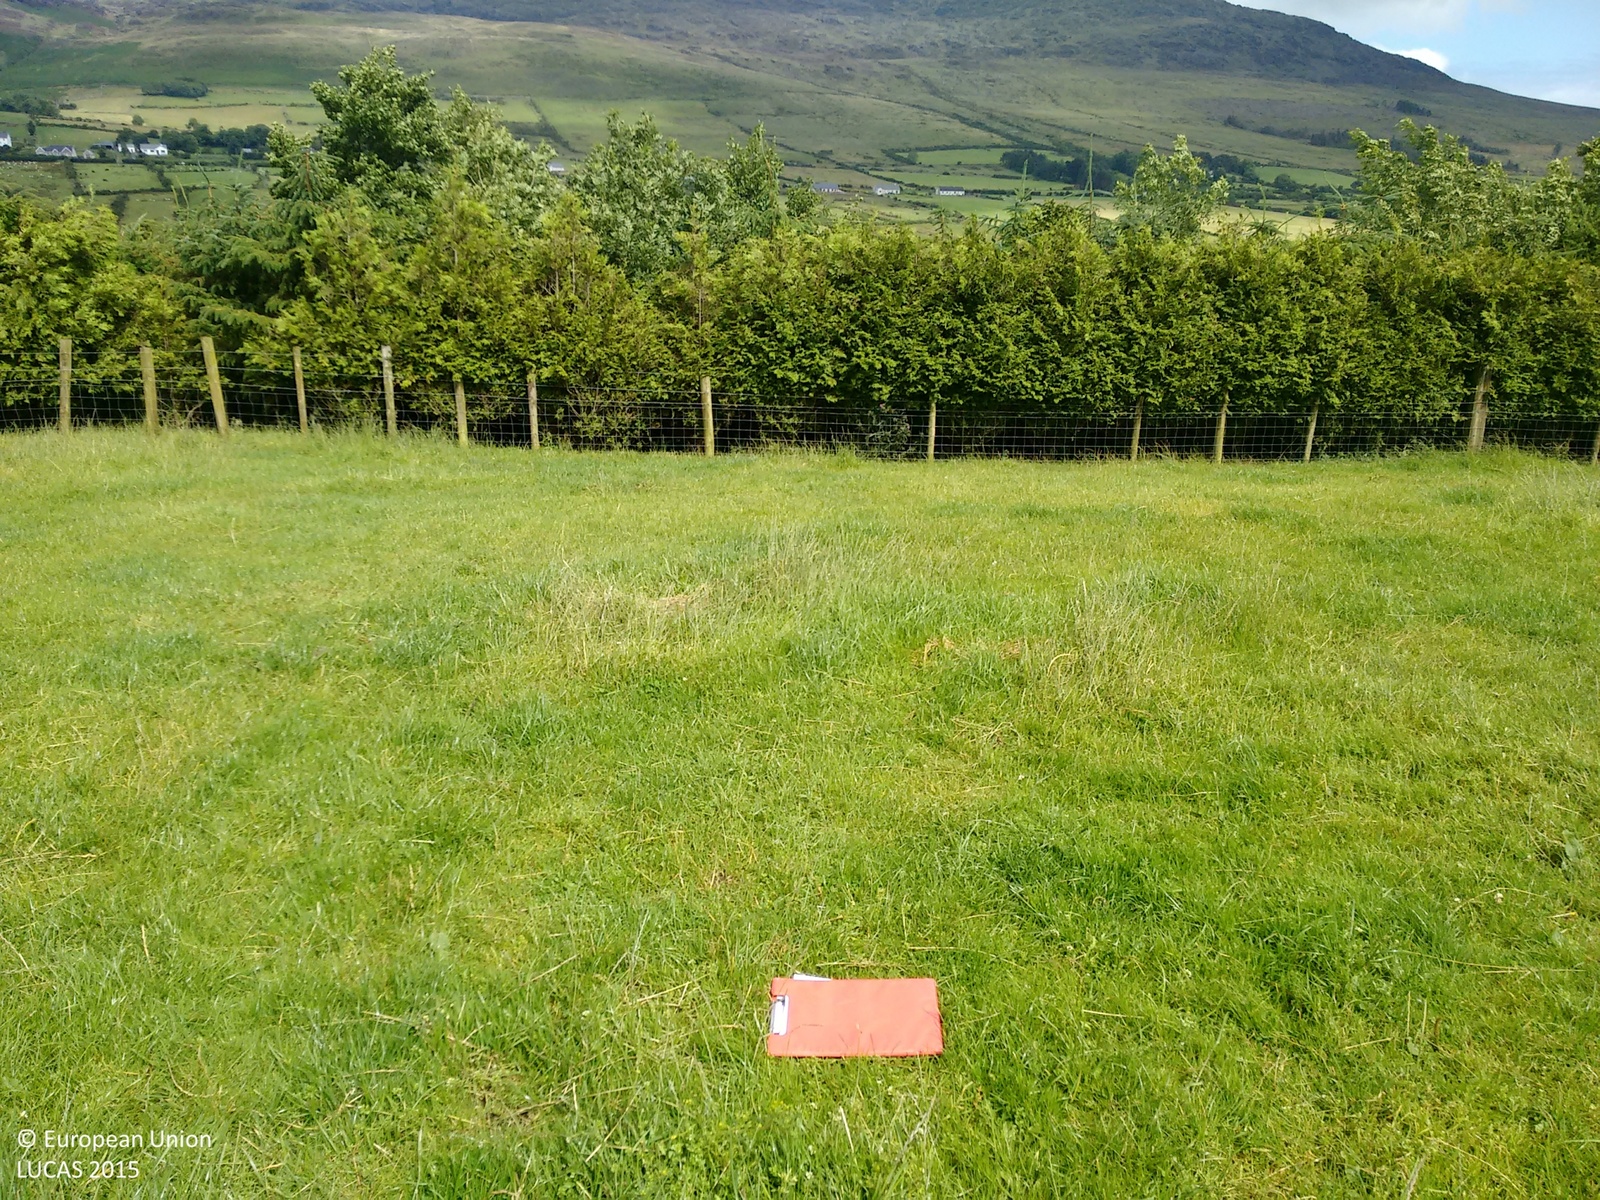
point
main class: Grassland
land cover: Grassland without tree/shrub cover
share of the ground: > 75 %
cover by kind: herbaceous plants 100 %
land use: Agriculture (excluding fallow land and kitchen gardens)
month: August
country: IE
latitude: 54.0374
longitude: -6.2582
